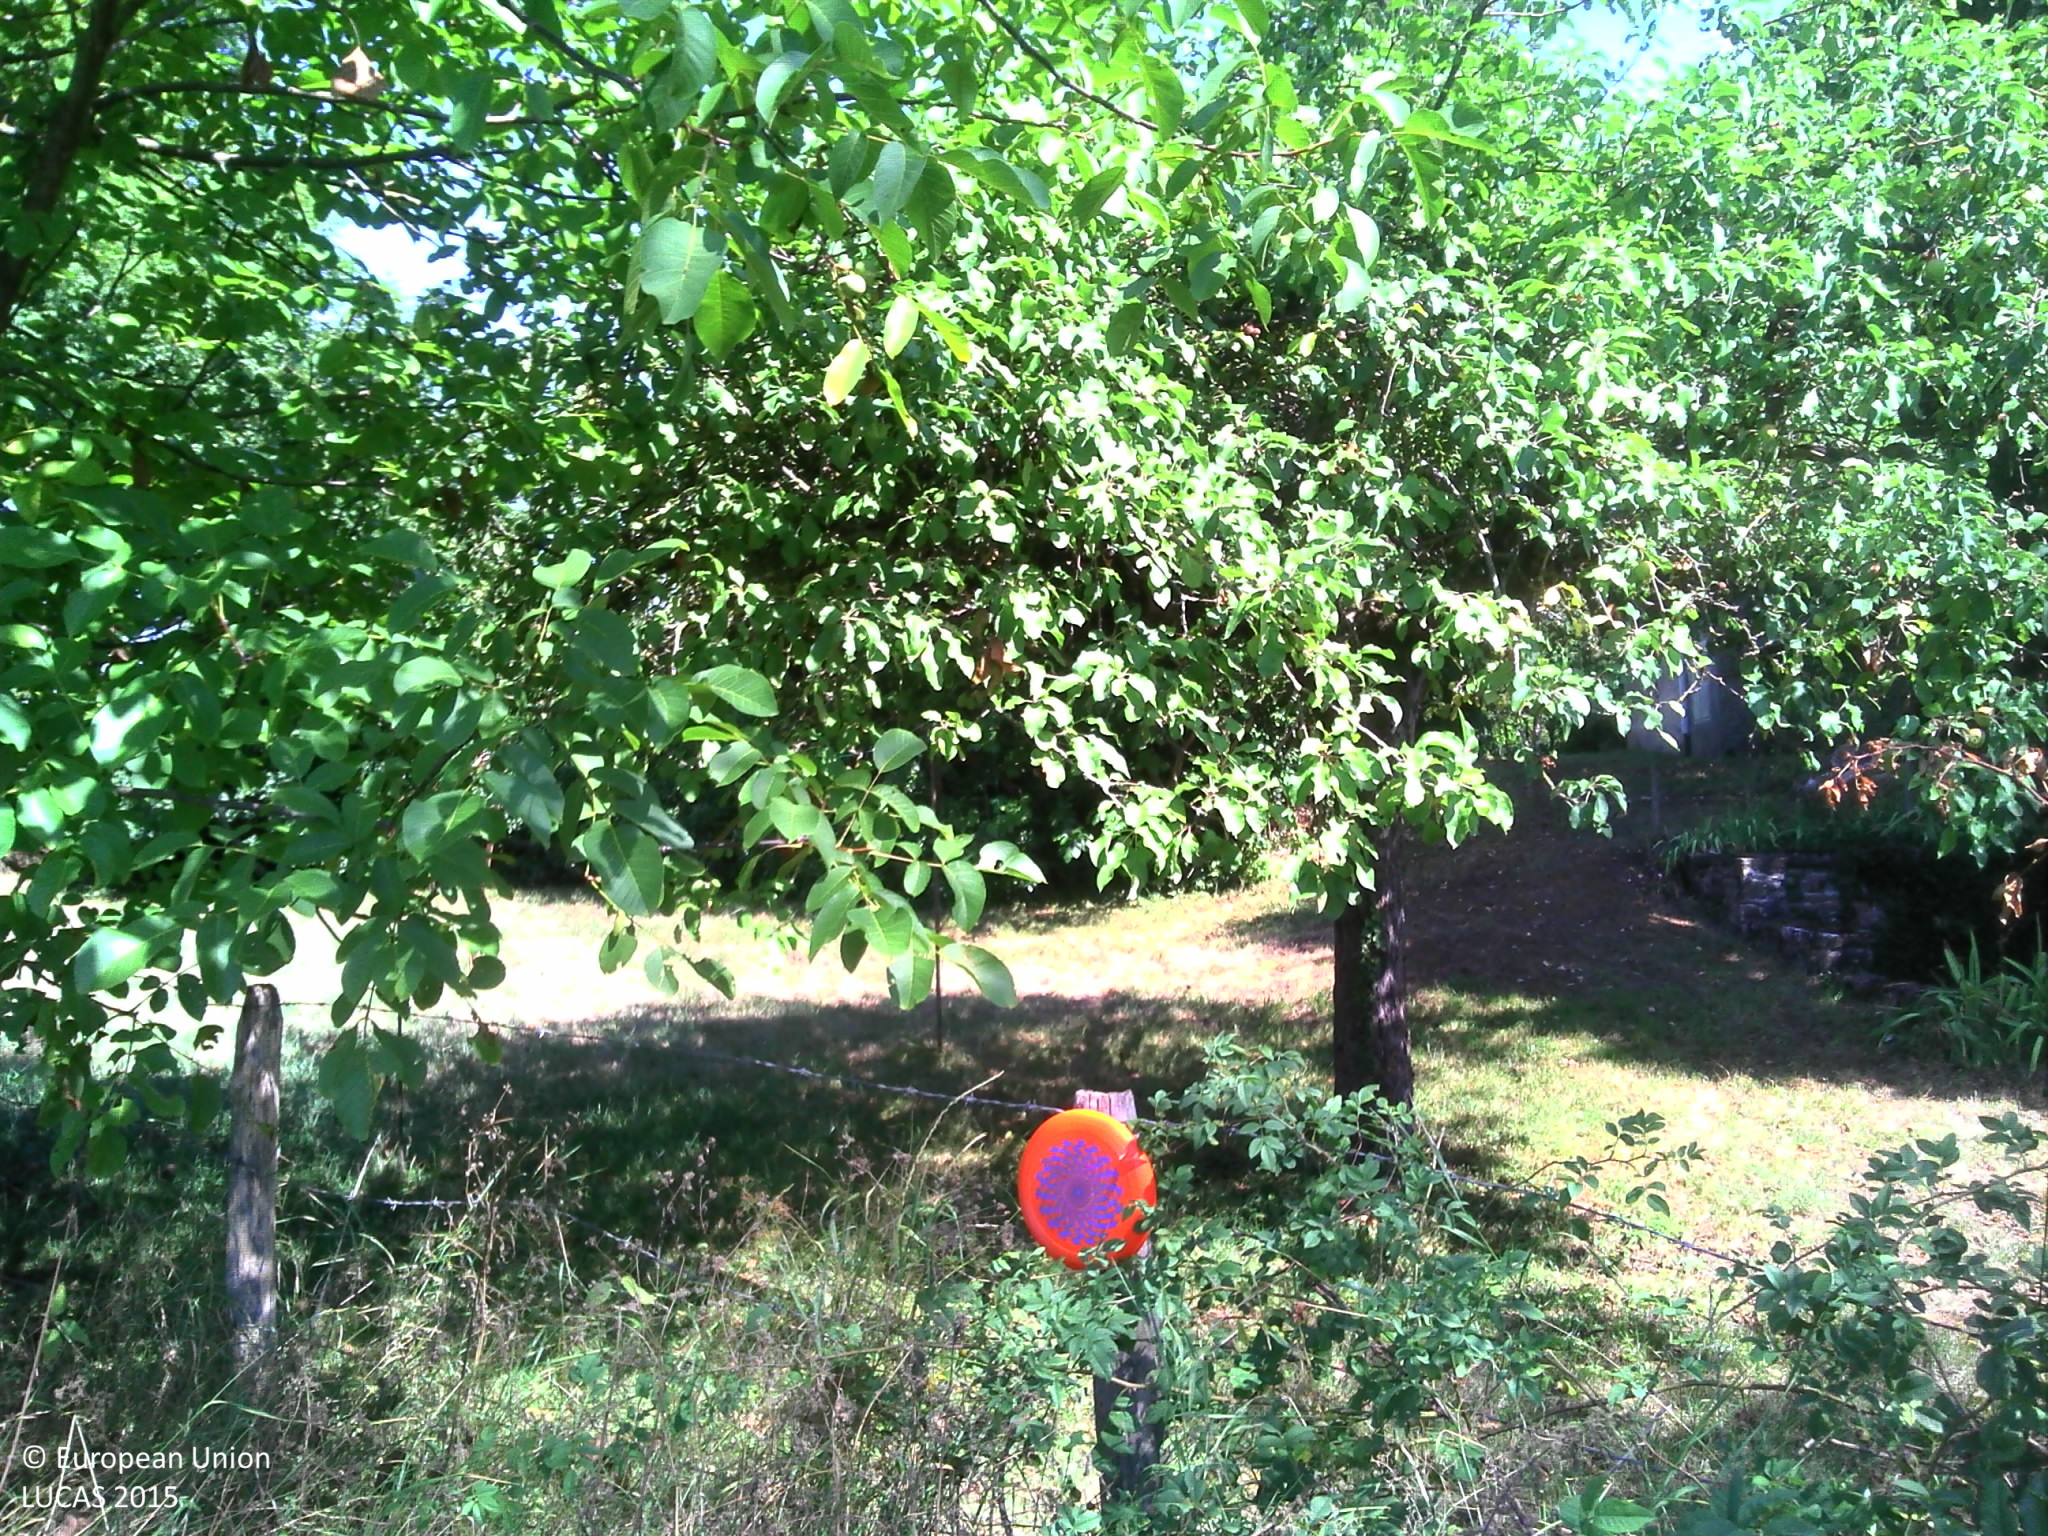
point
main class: Cropland
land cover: Apple fruit
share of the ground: > 75 %
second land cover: Grassland without tree/shrub cover
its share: > 75 %
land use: Kitchen garden
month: August
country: FR
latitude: 46.3327
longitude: 4.7930
